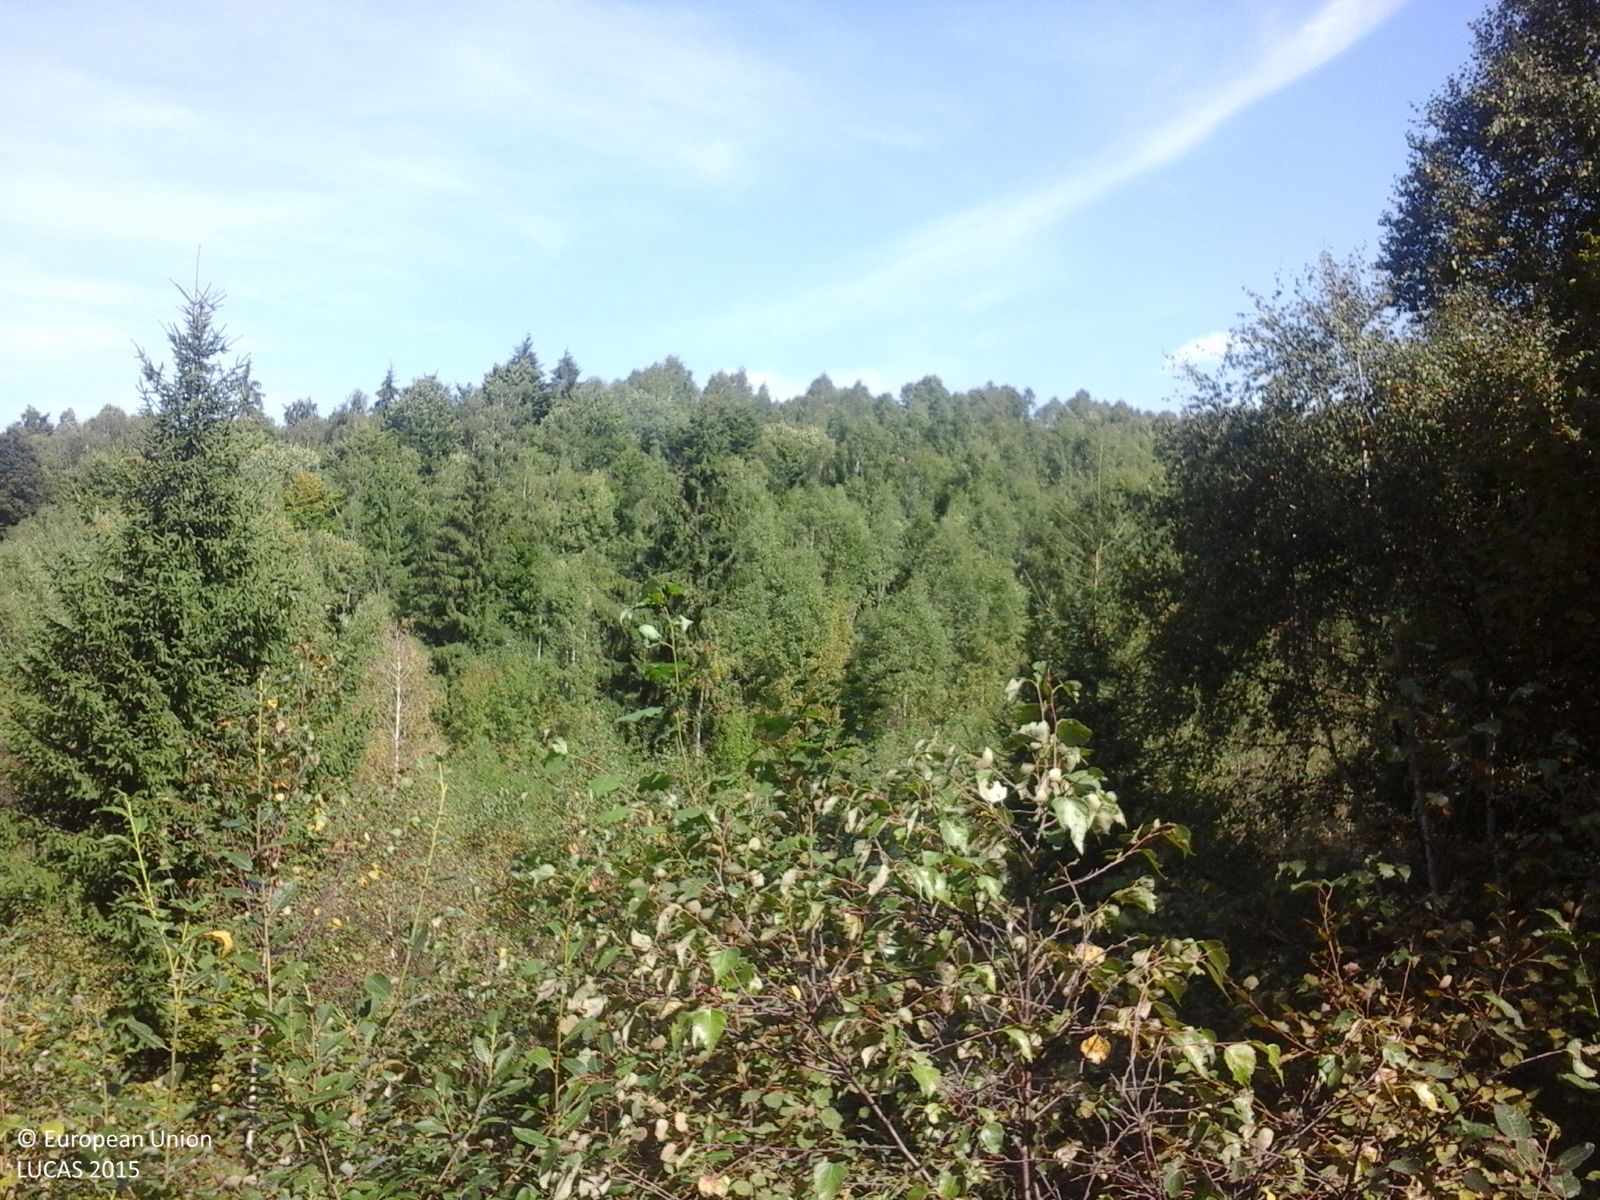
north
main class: Woodland
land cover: Spruce dominated mixed woodland
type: alpine coniferous forest
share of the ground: > 75 %
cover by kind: coniferous forest trees 50 %, broadleaved forest trees 40 %, shrubs 5 %, herbaceous plants 5 %
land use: Forestry
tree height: > 5 m
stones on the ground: < 10 %
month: September
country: RO
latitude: 46.7290
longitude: 23.0818
